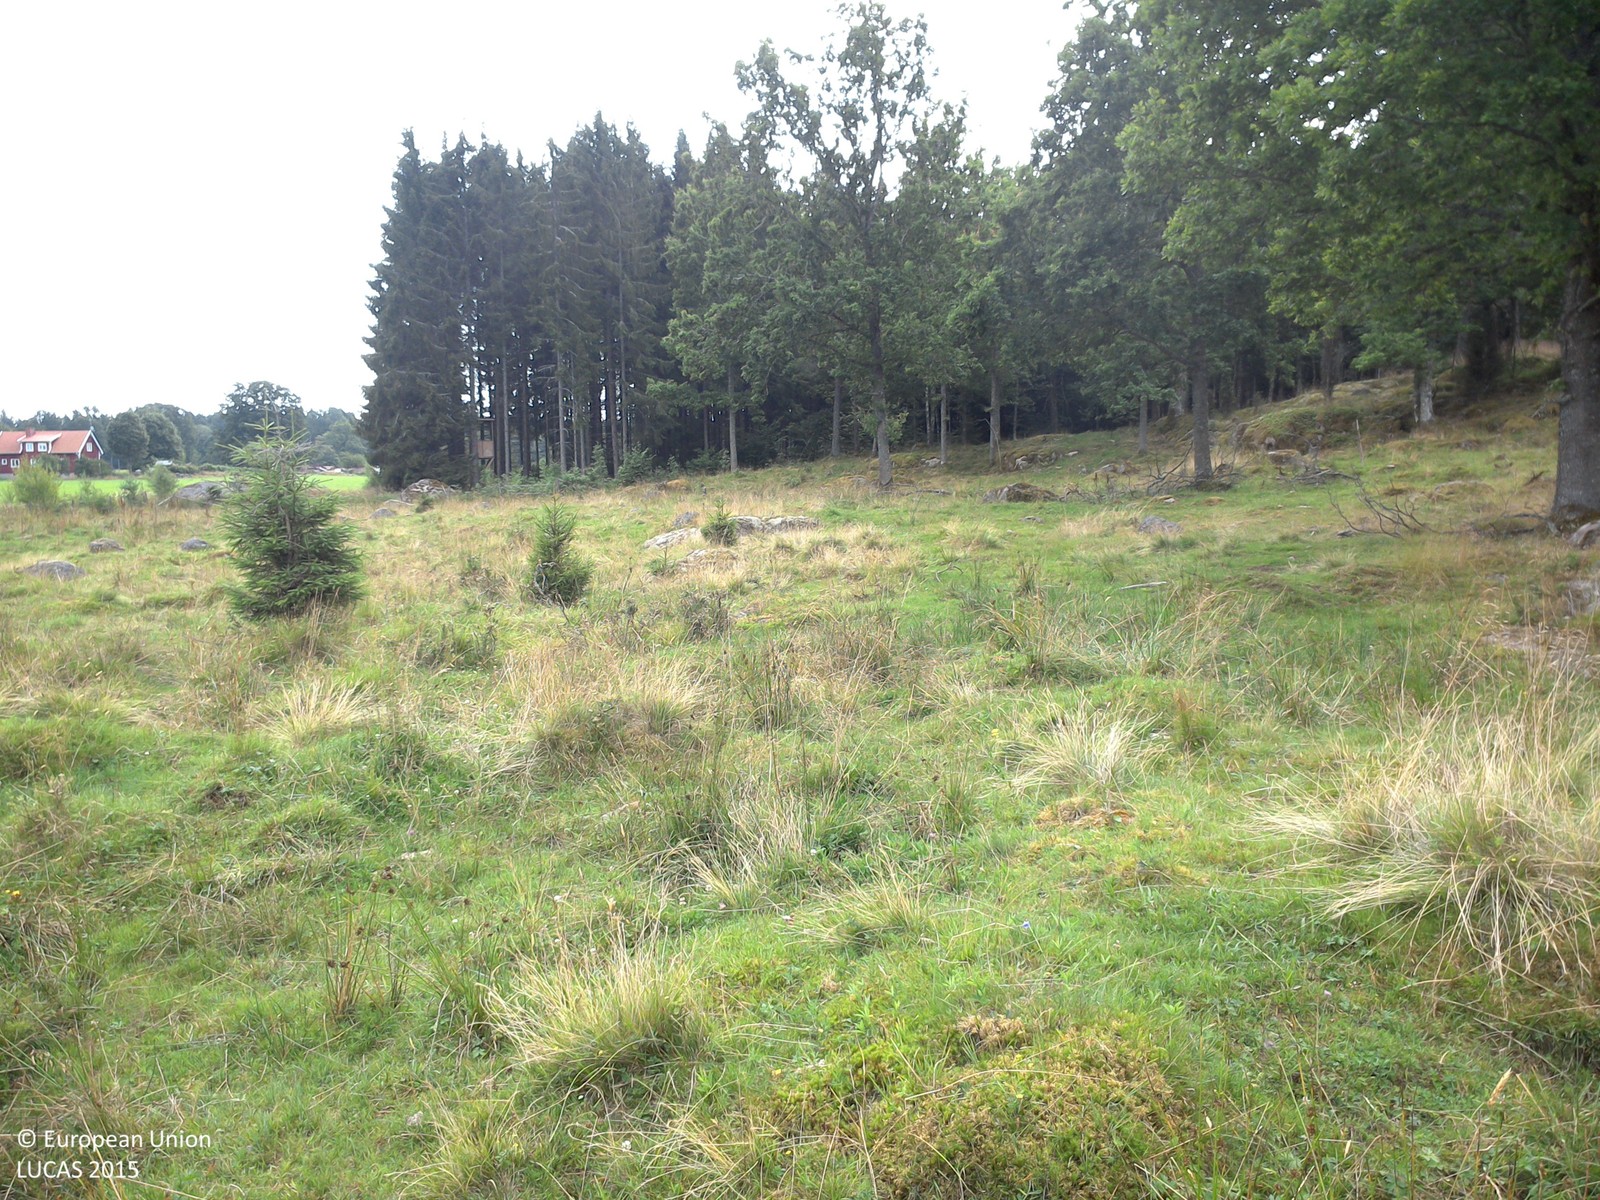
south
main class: Grassland
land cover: Grassland without tree/shrub cover
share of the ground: > 75 %
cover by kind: herbaceous plants 100 %
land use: Agriculture (excluding fallow land and kitchen gardens)
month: August
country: SE
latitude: 58.1900
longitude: 14.7400
